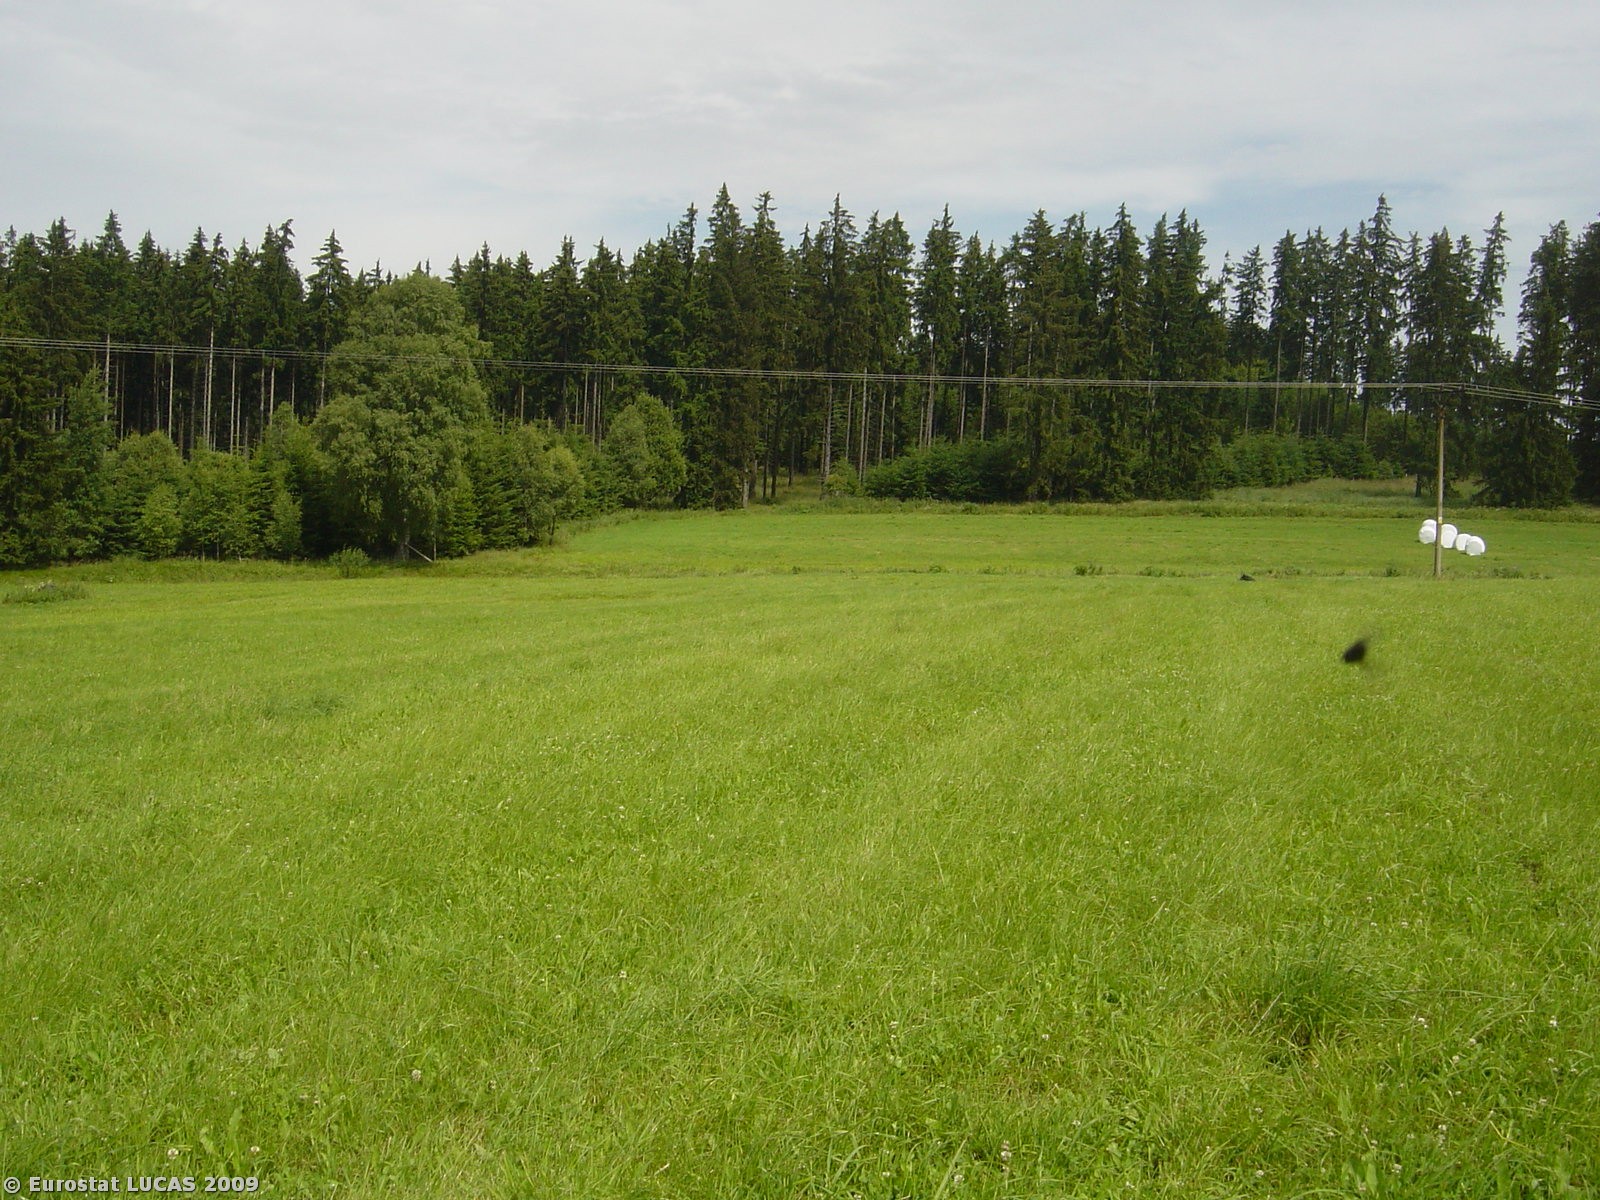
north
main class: Grassland
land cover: Grassland without tree/shrub cover
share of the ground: > 75 %
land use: Agriculture (excluding fallow land and kitchen gardens)
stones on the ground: 10 - 25 %
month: July
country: CZ
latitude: 49.9671
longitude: 12.9136
